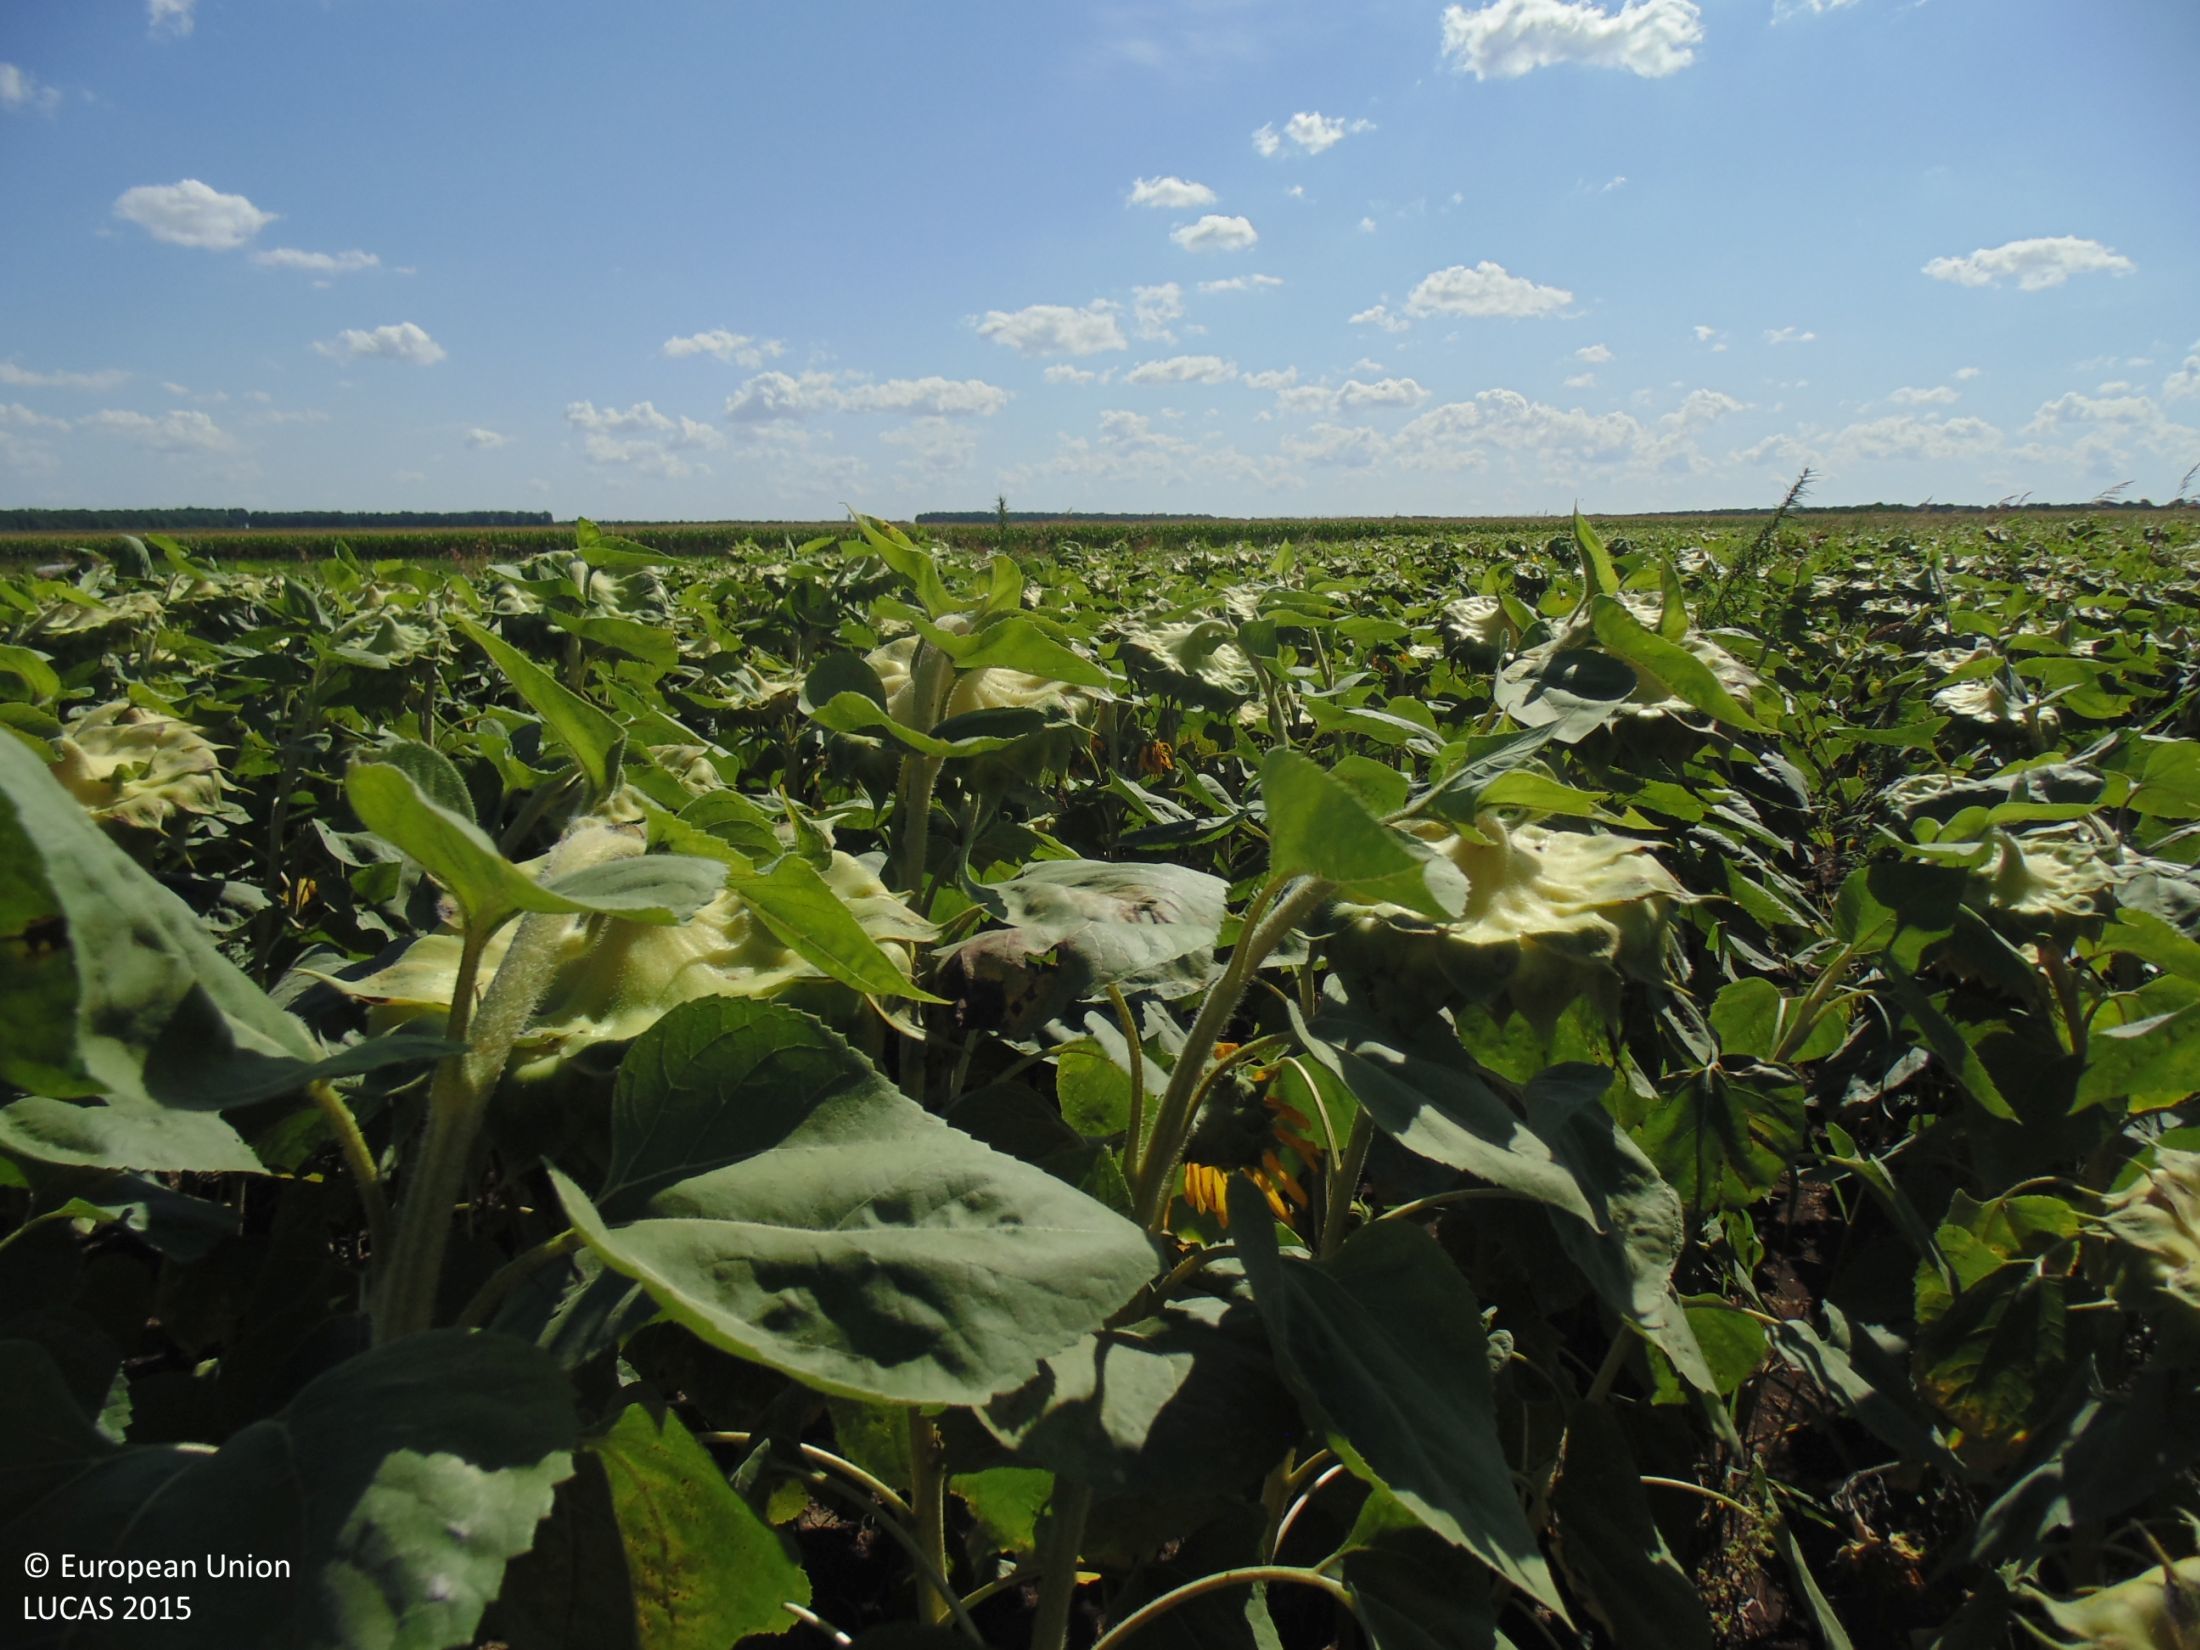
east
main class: Cropland
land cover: Sunflower
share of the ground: > 75 %
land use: Agriculture (excluding fallow land and kitchen gardens)
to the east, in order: Sunflower; Grass margins; Tracks; Grass margins; Maize
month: August
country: BG
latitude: 43.7437
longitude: 27.8645
